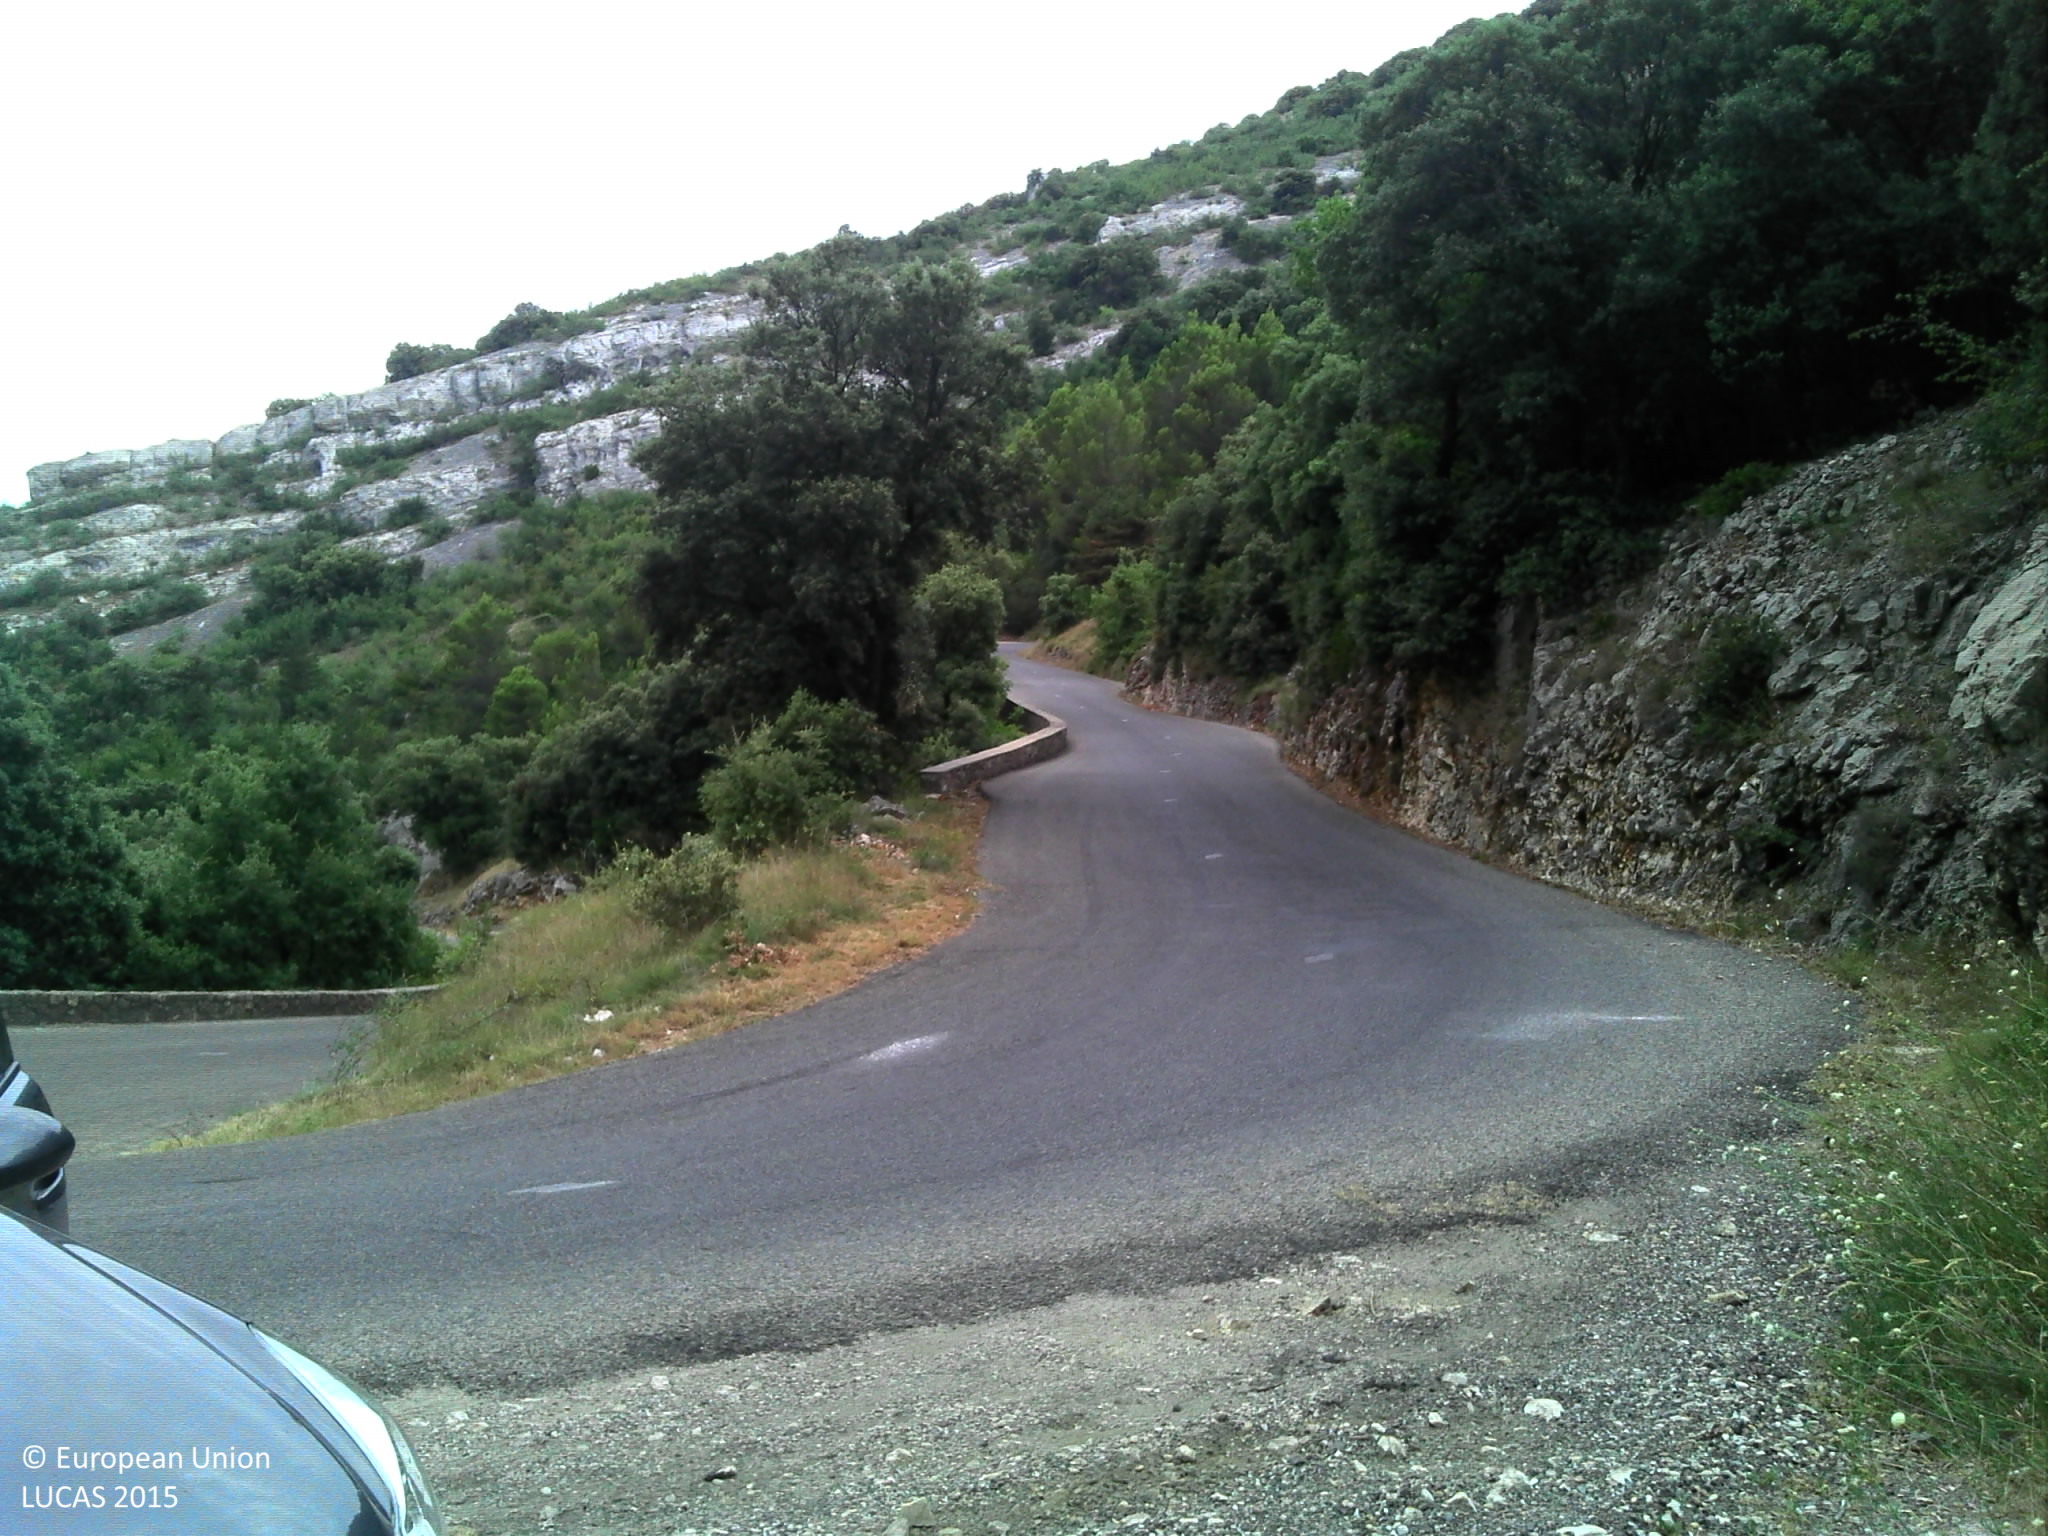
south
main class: Woodland
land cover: Broadleaved woodland
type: broadleaved evergreen forest
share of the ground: > 75 %
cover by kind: broadleaved forest trees 50 %
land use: Semi-natural and natural areas not in use
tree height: > 5 m
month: July
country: FR
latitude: 44.4458
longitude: 4.6164
